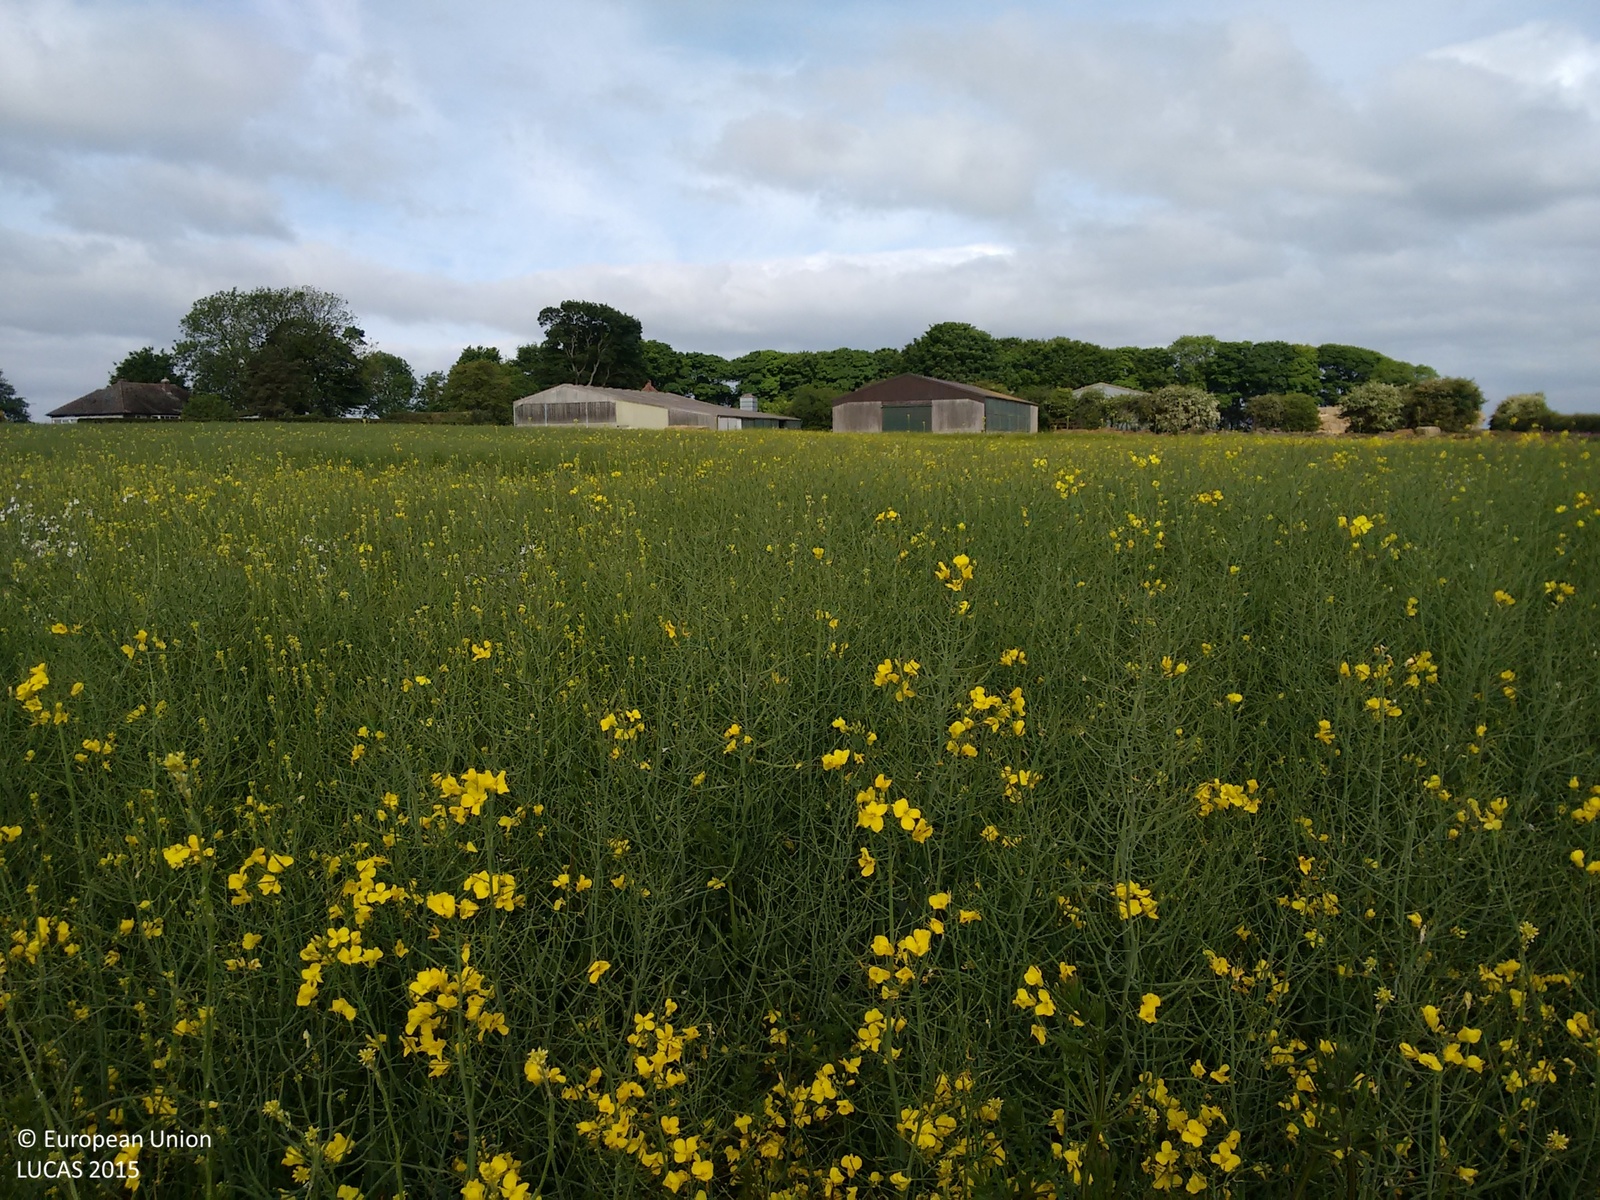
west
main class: Cropland
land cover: Rape and turnip rape
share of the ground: > 75 %
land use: Agriculture (excluding fallow land and kitchen gardens)
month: June
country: GB
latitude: 54.1903
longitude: -0.3487
